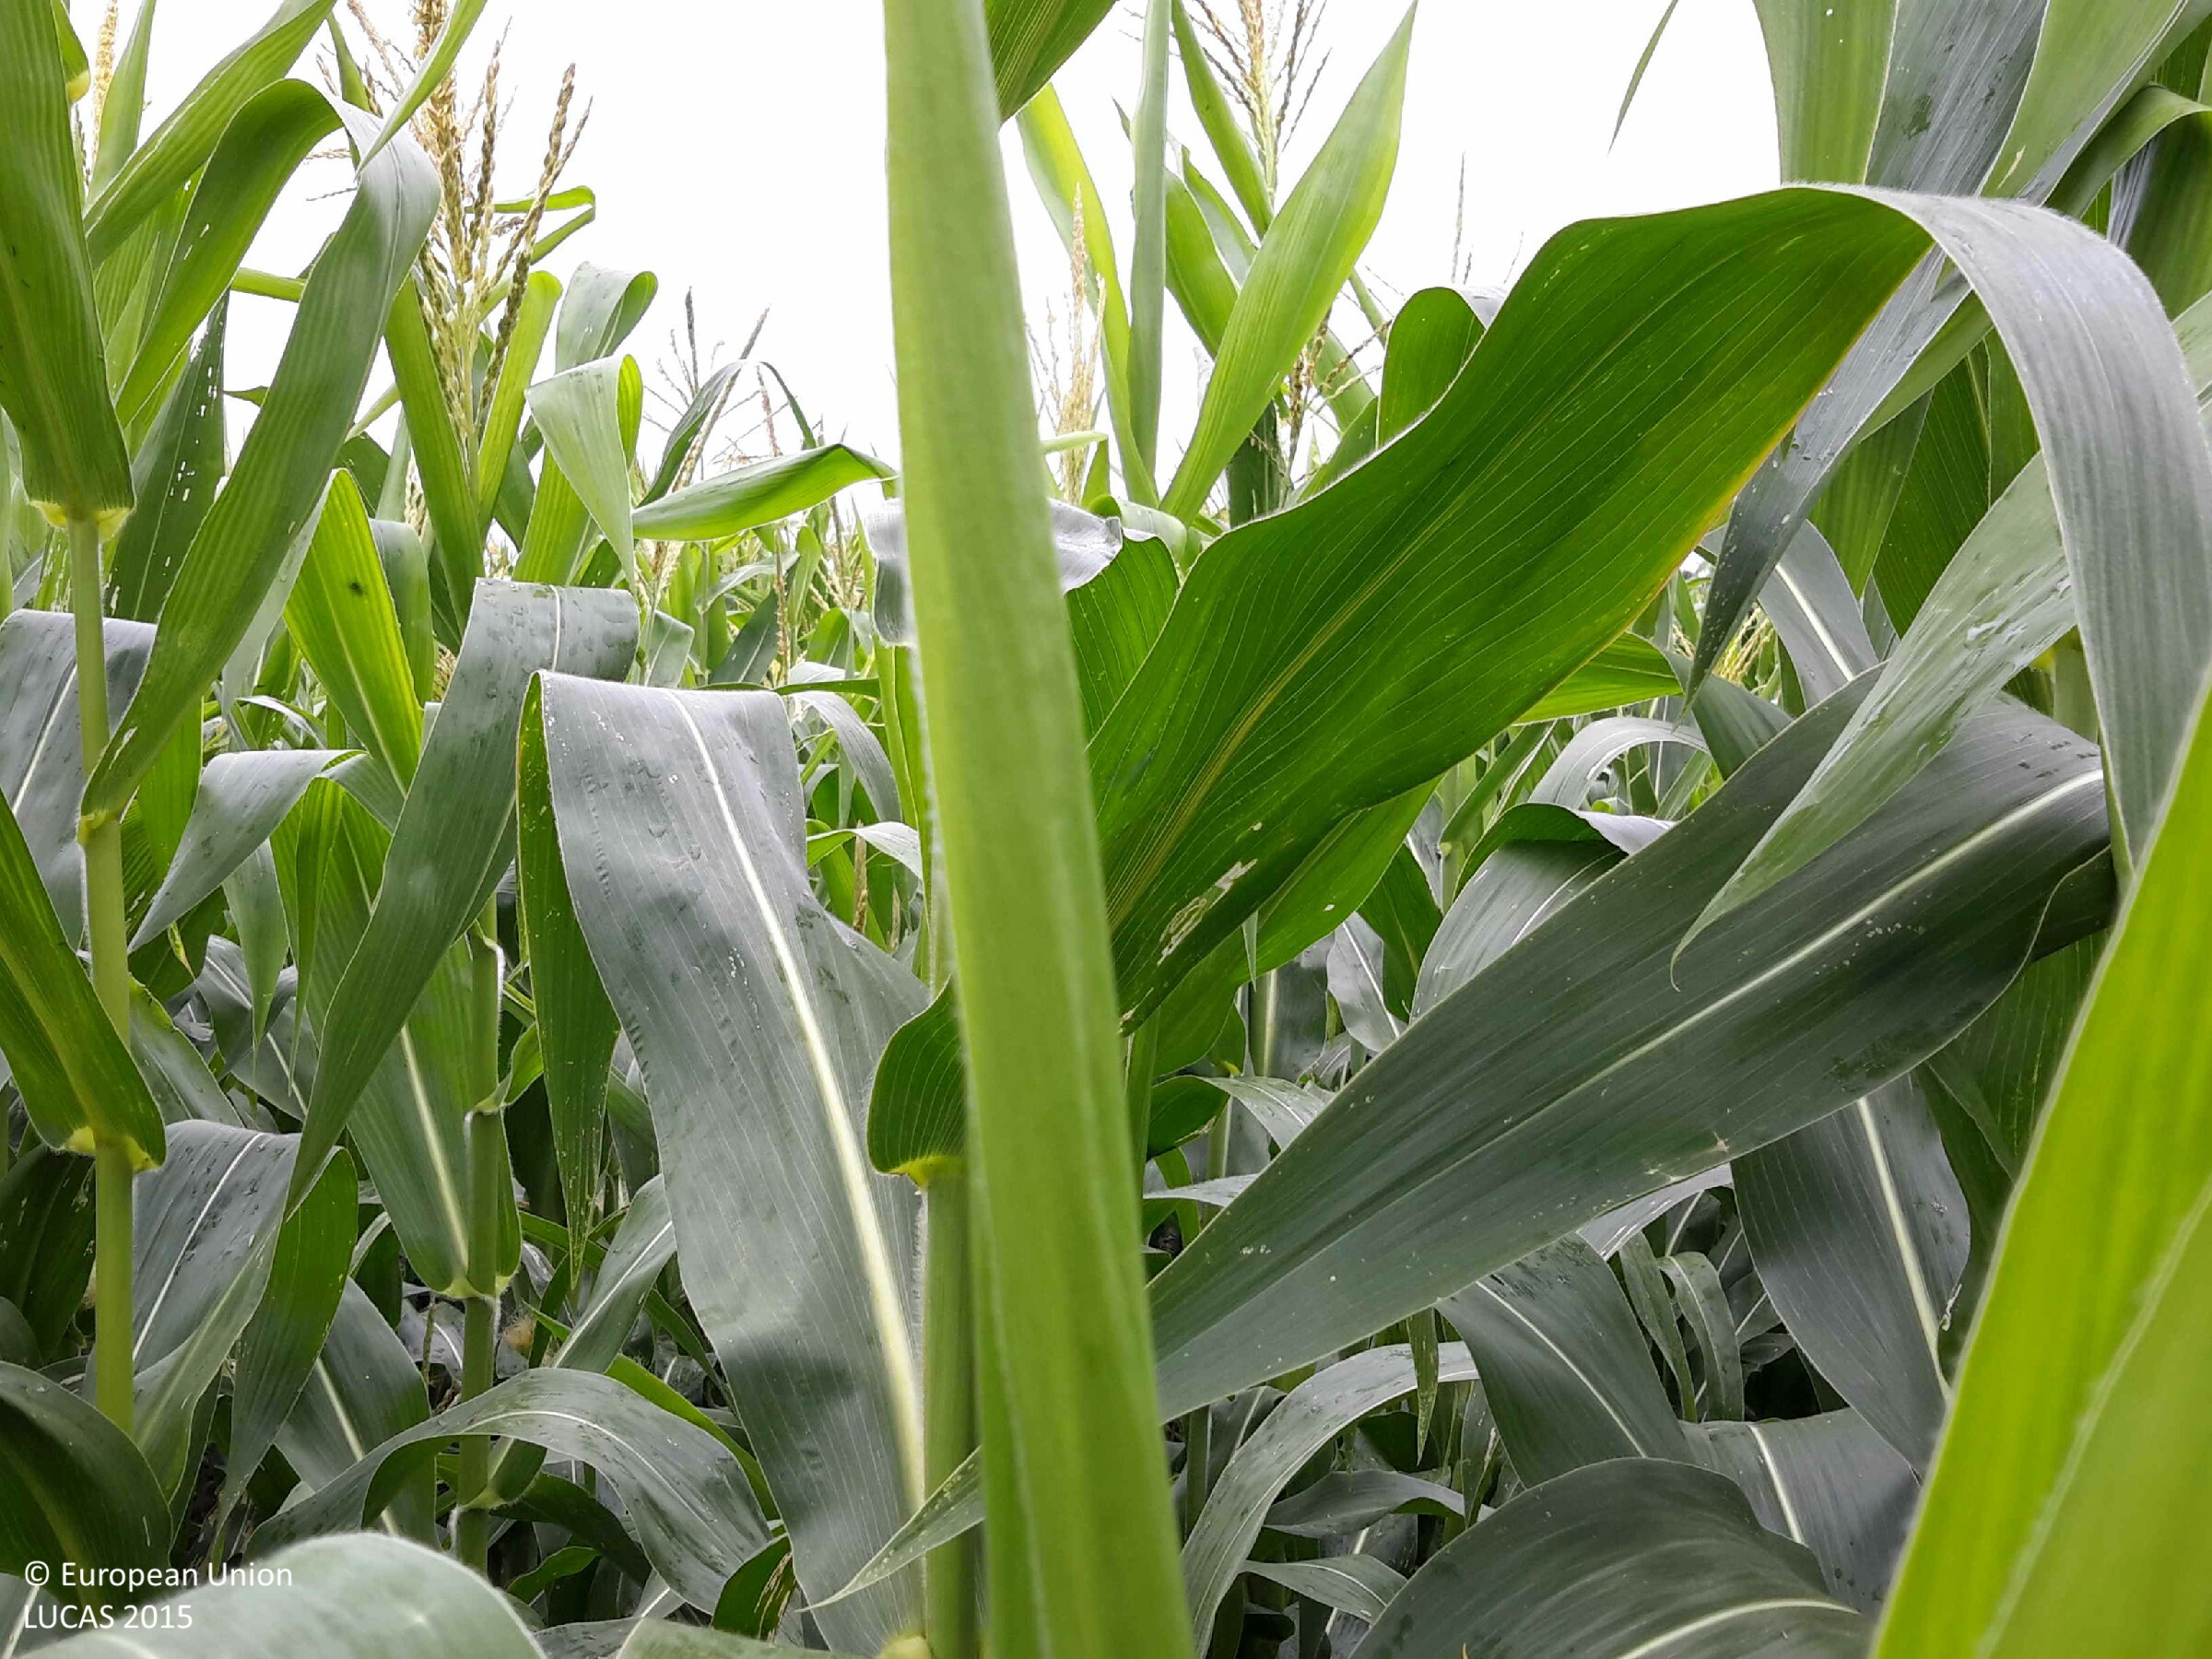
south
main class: Cropland
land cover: Maize
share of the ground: > 75 %
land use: Agriculture (excluding fallow land and kitchen gardens)
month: July
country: HU
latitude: 47.4956
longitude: 17.5346
